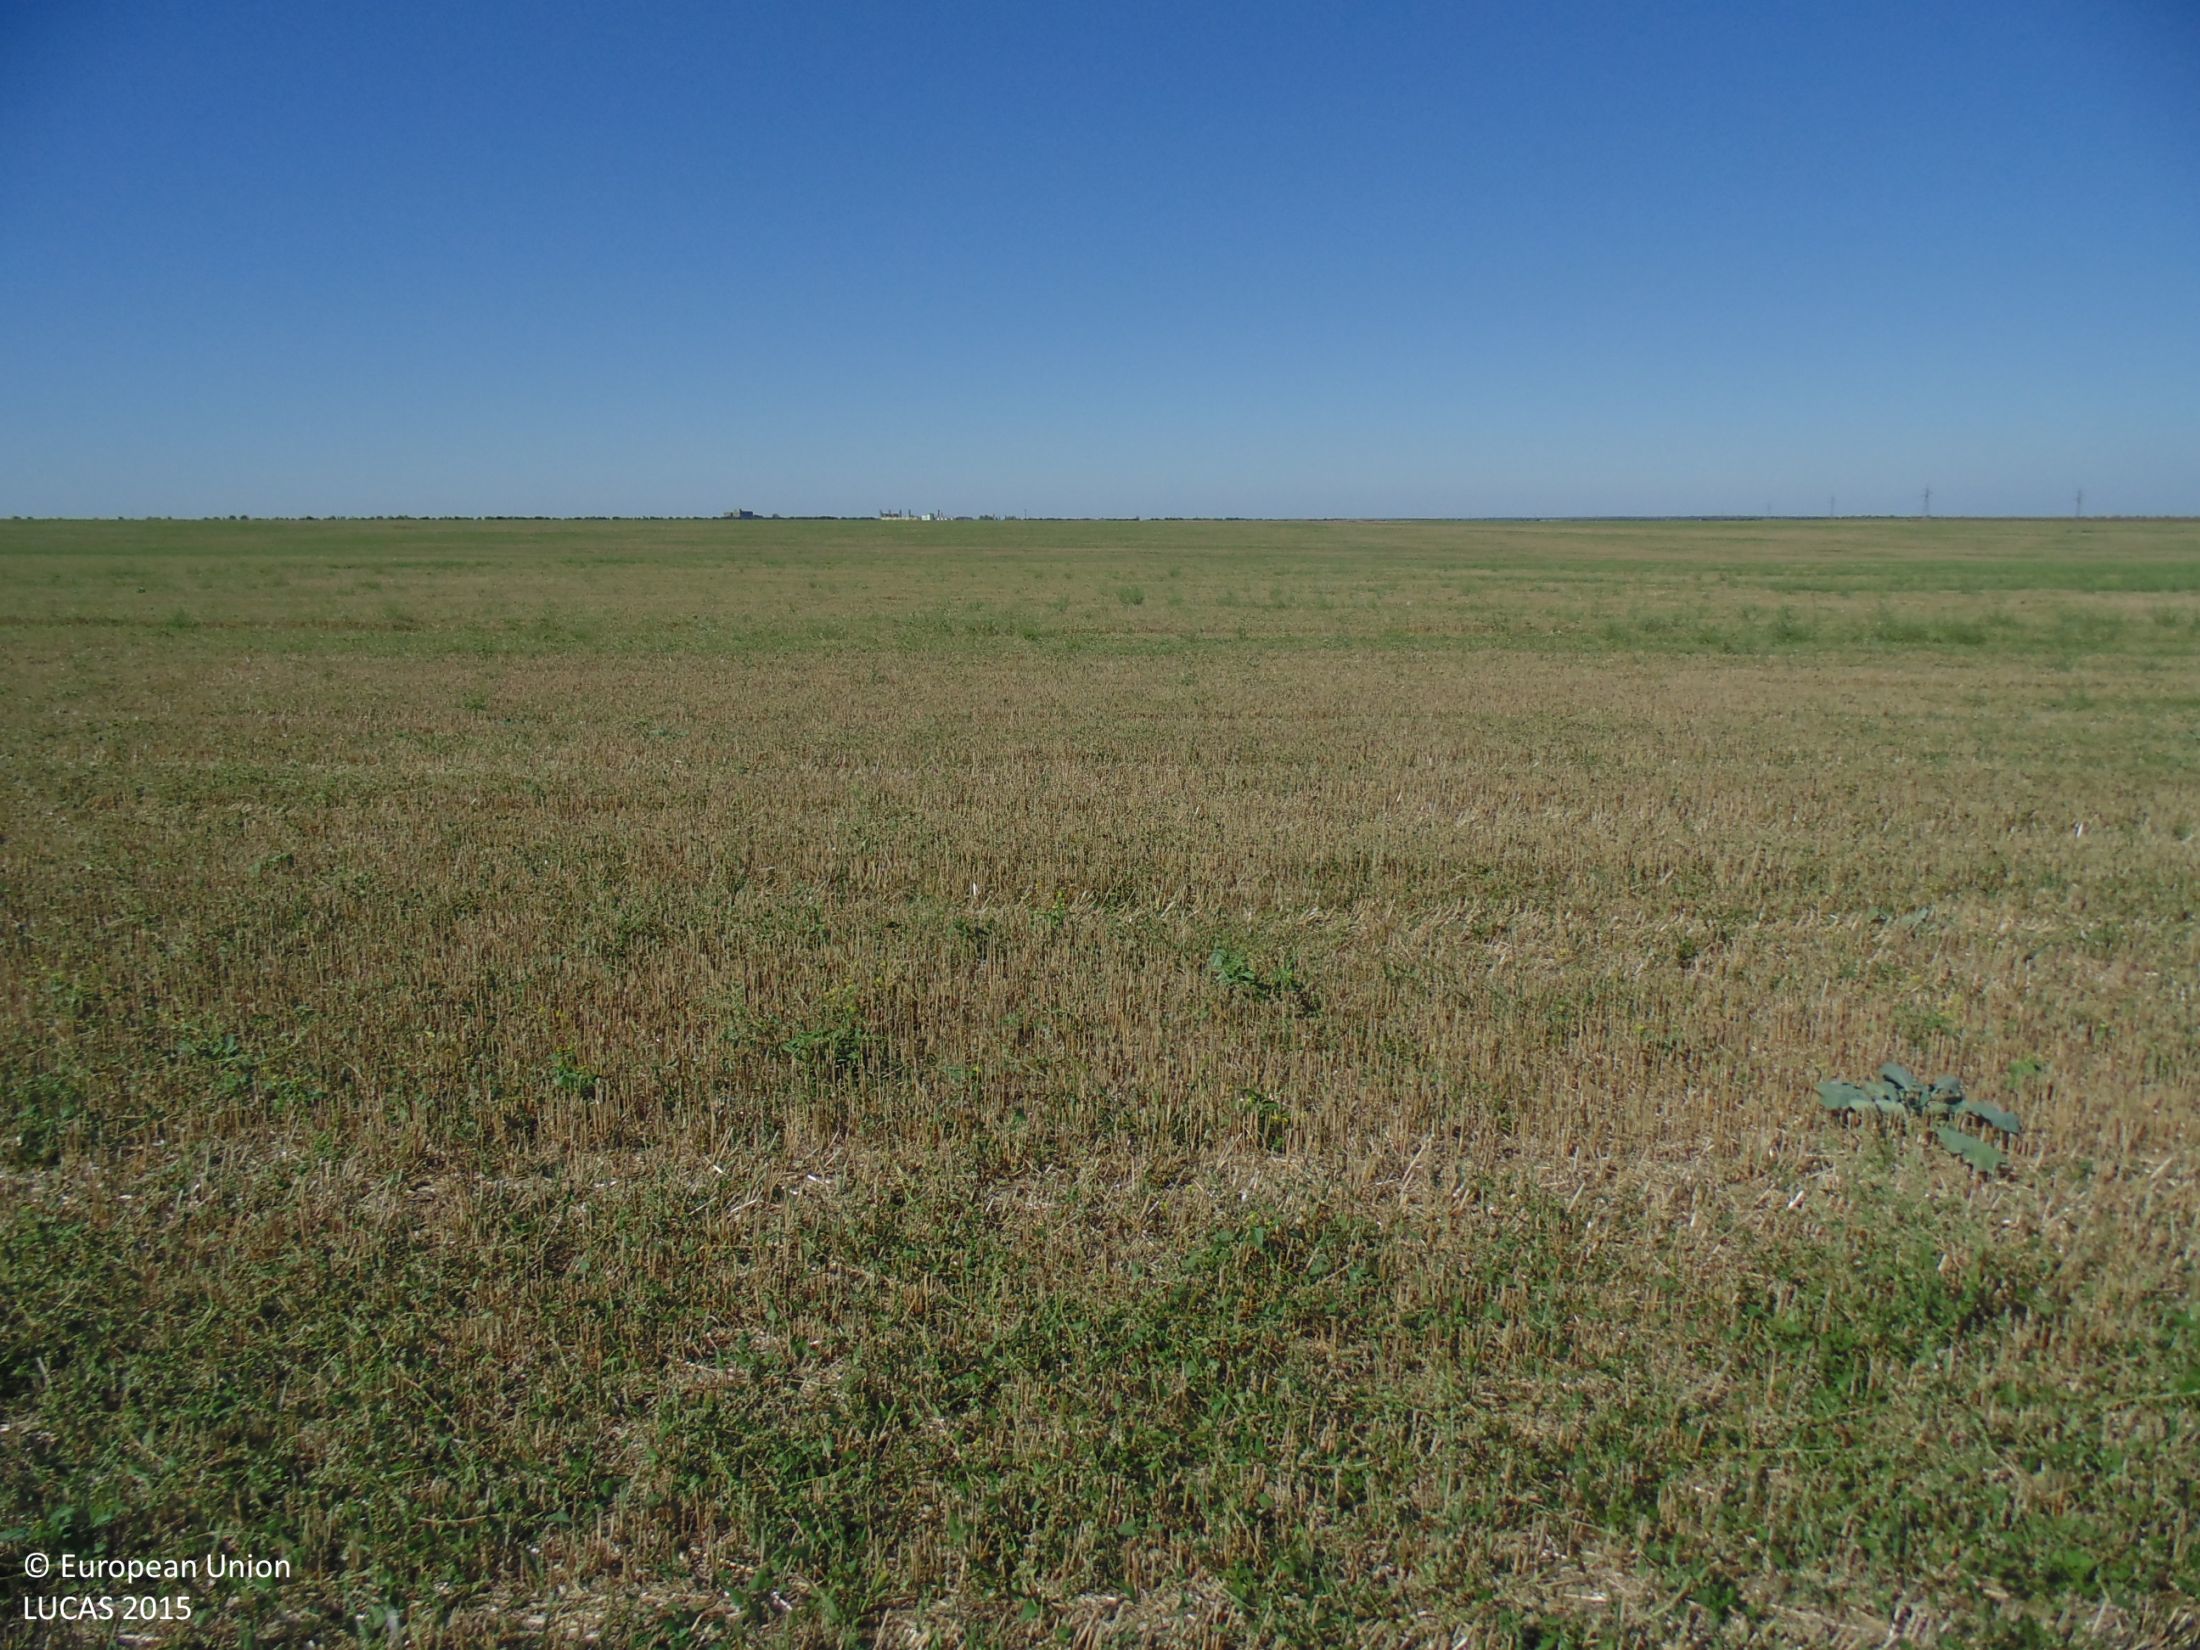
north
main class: Cropland
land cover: Common wheat
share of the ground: 50 - 75 %
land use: Agriculture (excluding fallow land and kitchen gardens)
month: September
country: BG
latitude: 43.7561
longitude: 27.1525
